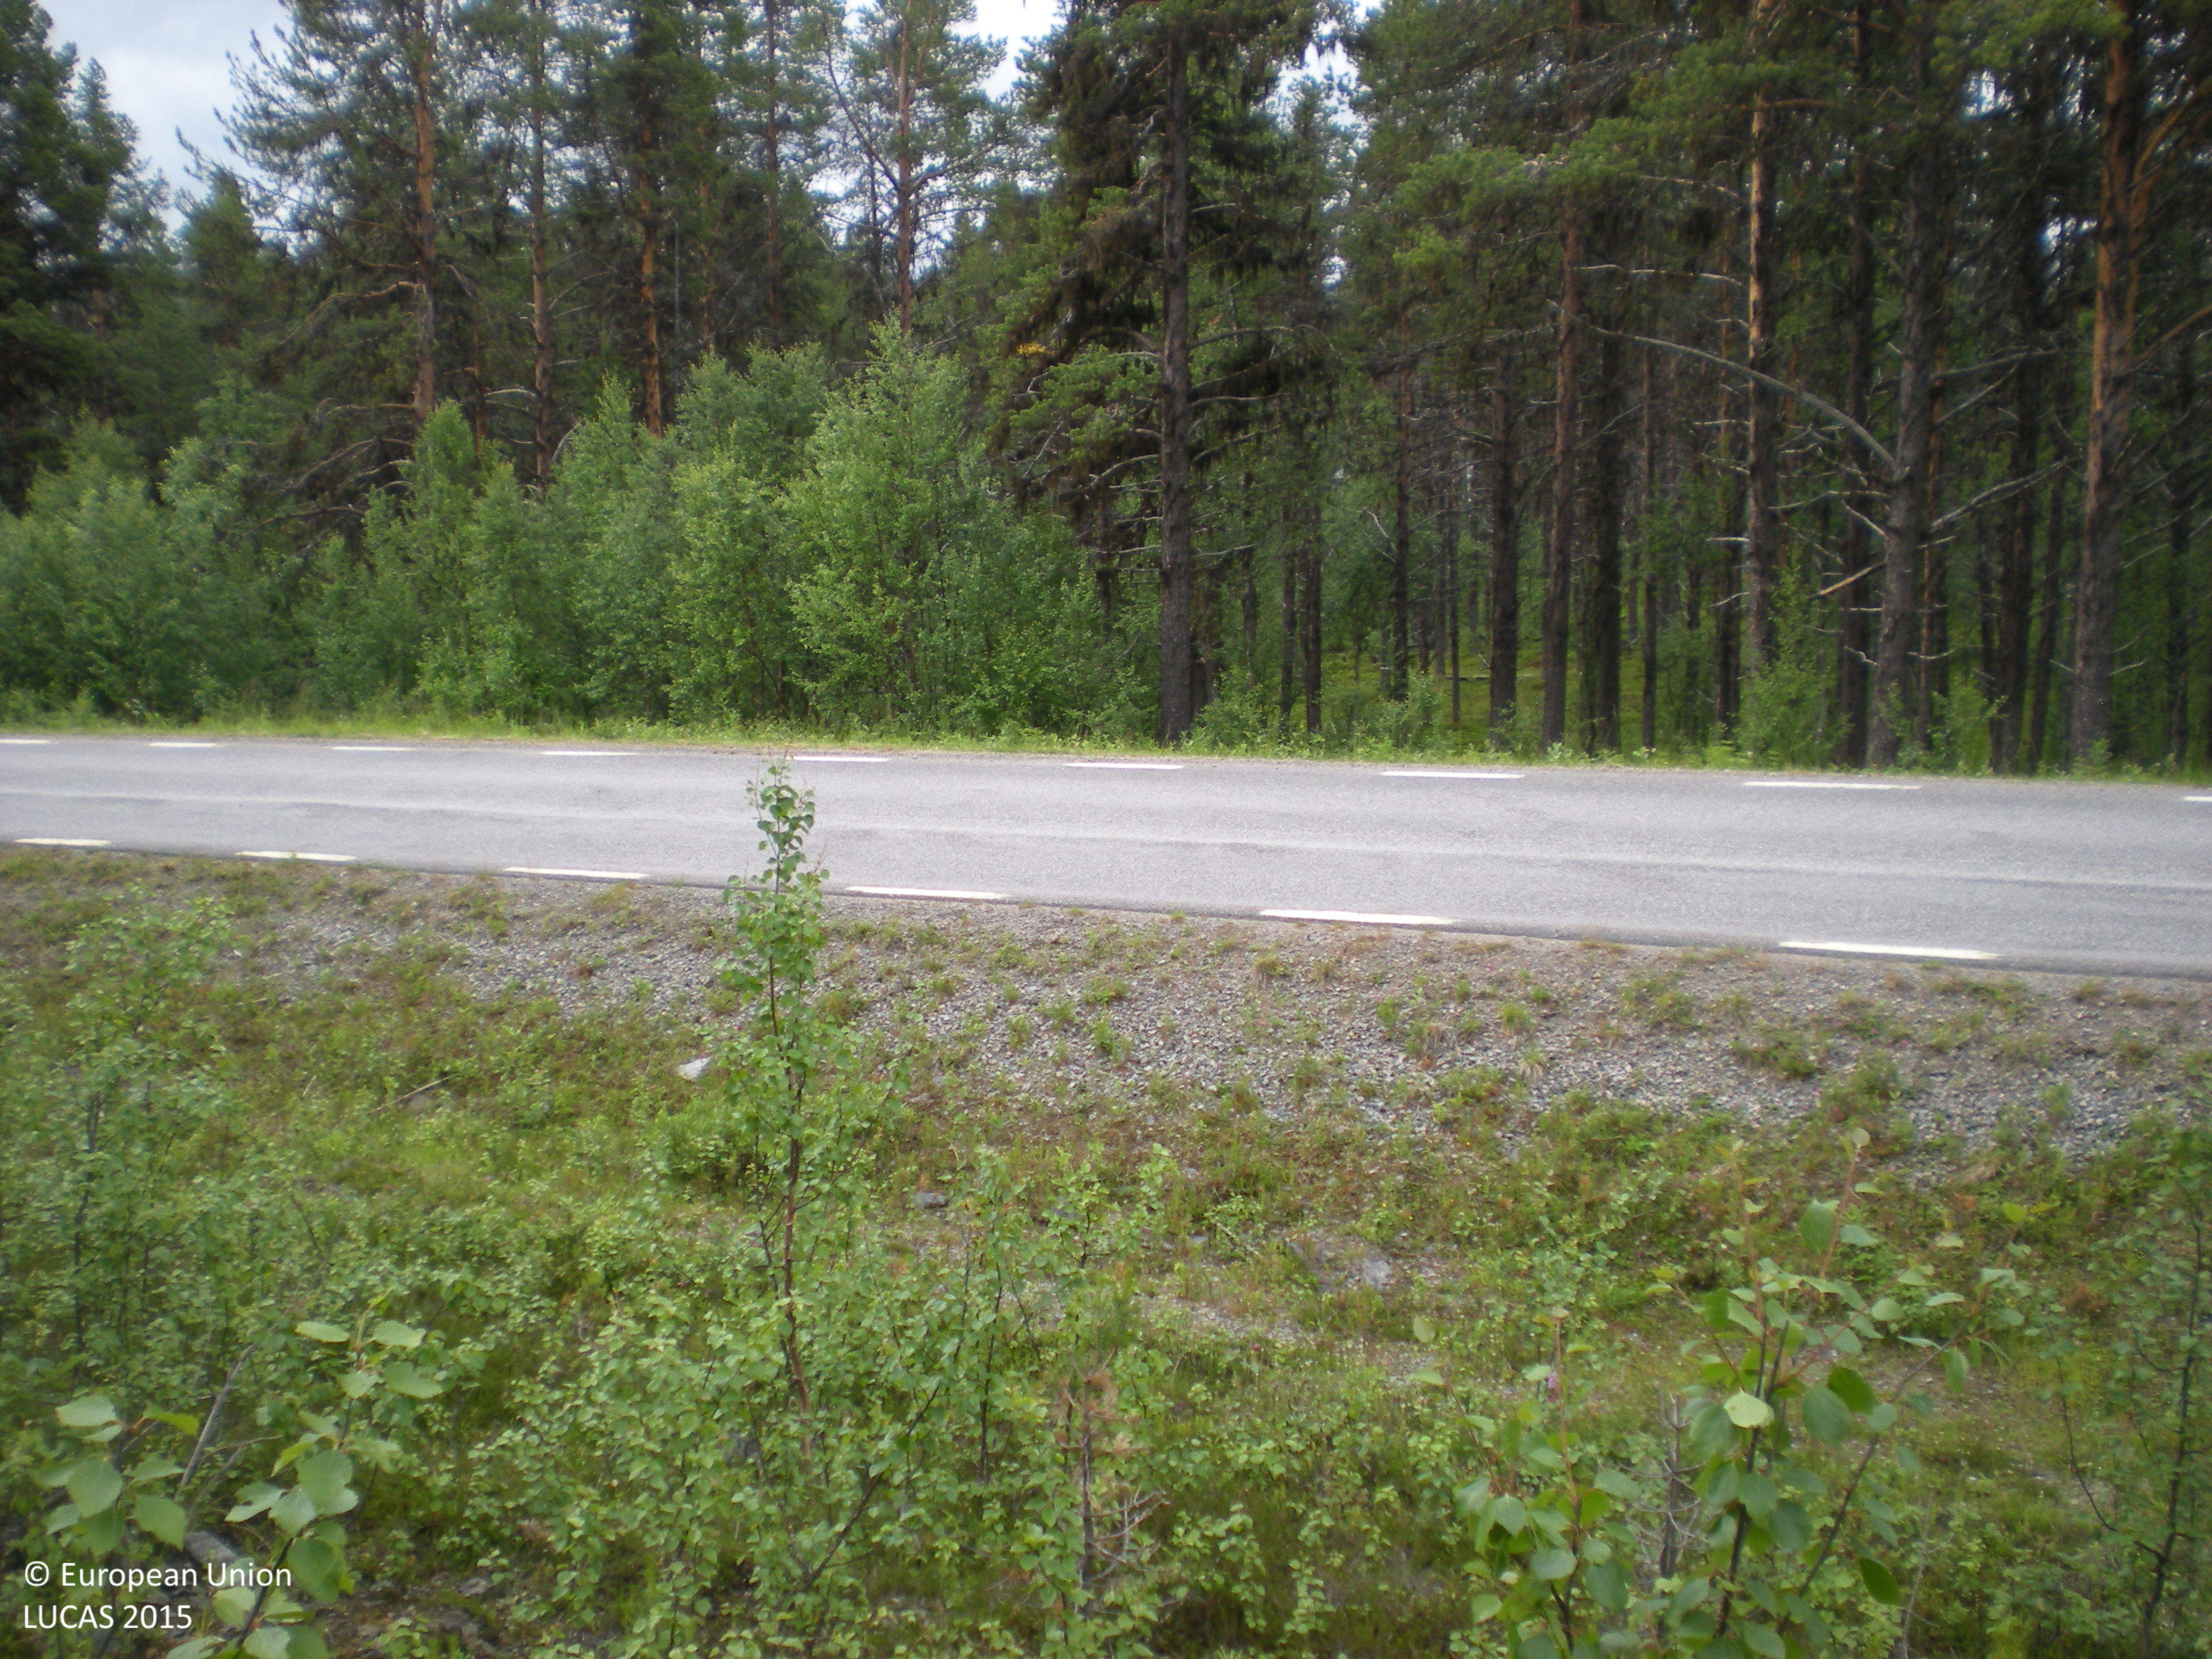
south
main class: Woodland
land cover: Broadleaved woodland
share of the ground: 25 - 50 %
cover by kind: broadleaved forest trees 40 %, shrubs 40 %, lichens and mosses 10 %, coniferous forest trees 5 %, consolidated bare surface 5 %
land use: Forestry
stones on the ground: > 50 %
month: July
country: SE
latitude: 66.2422
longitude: 16.9620
